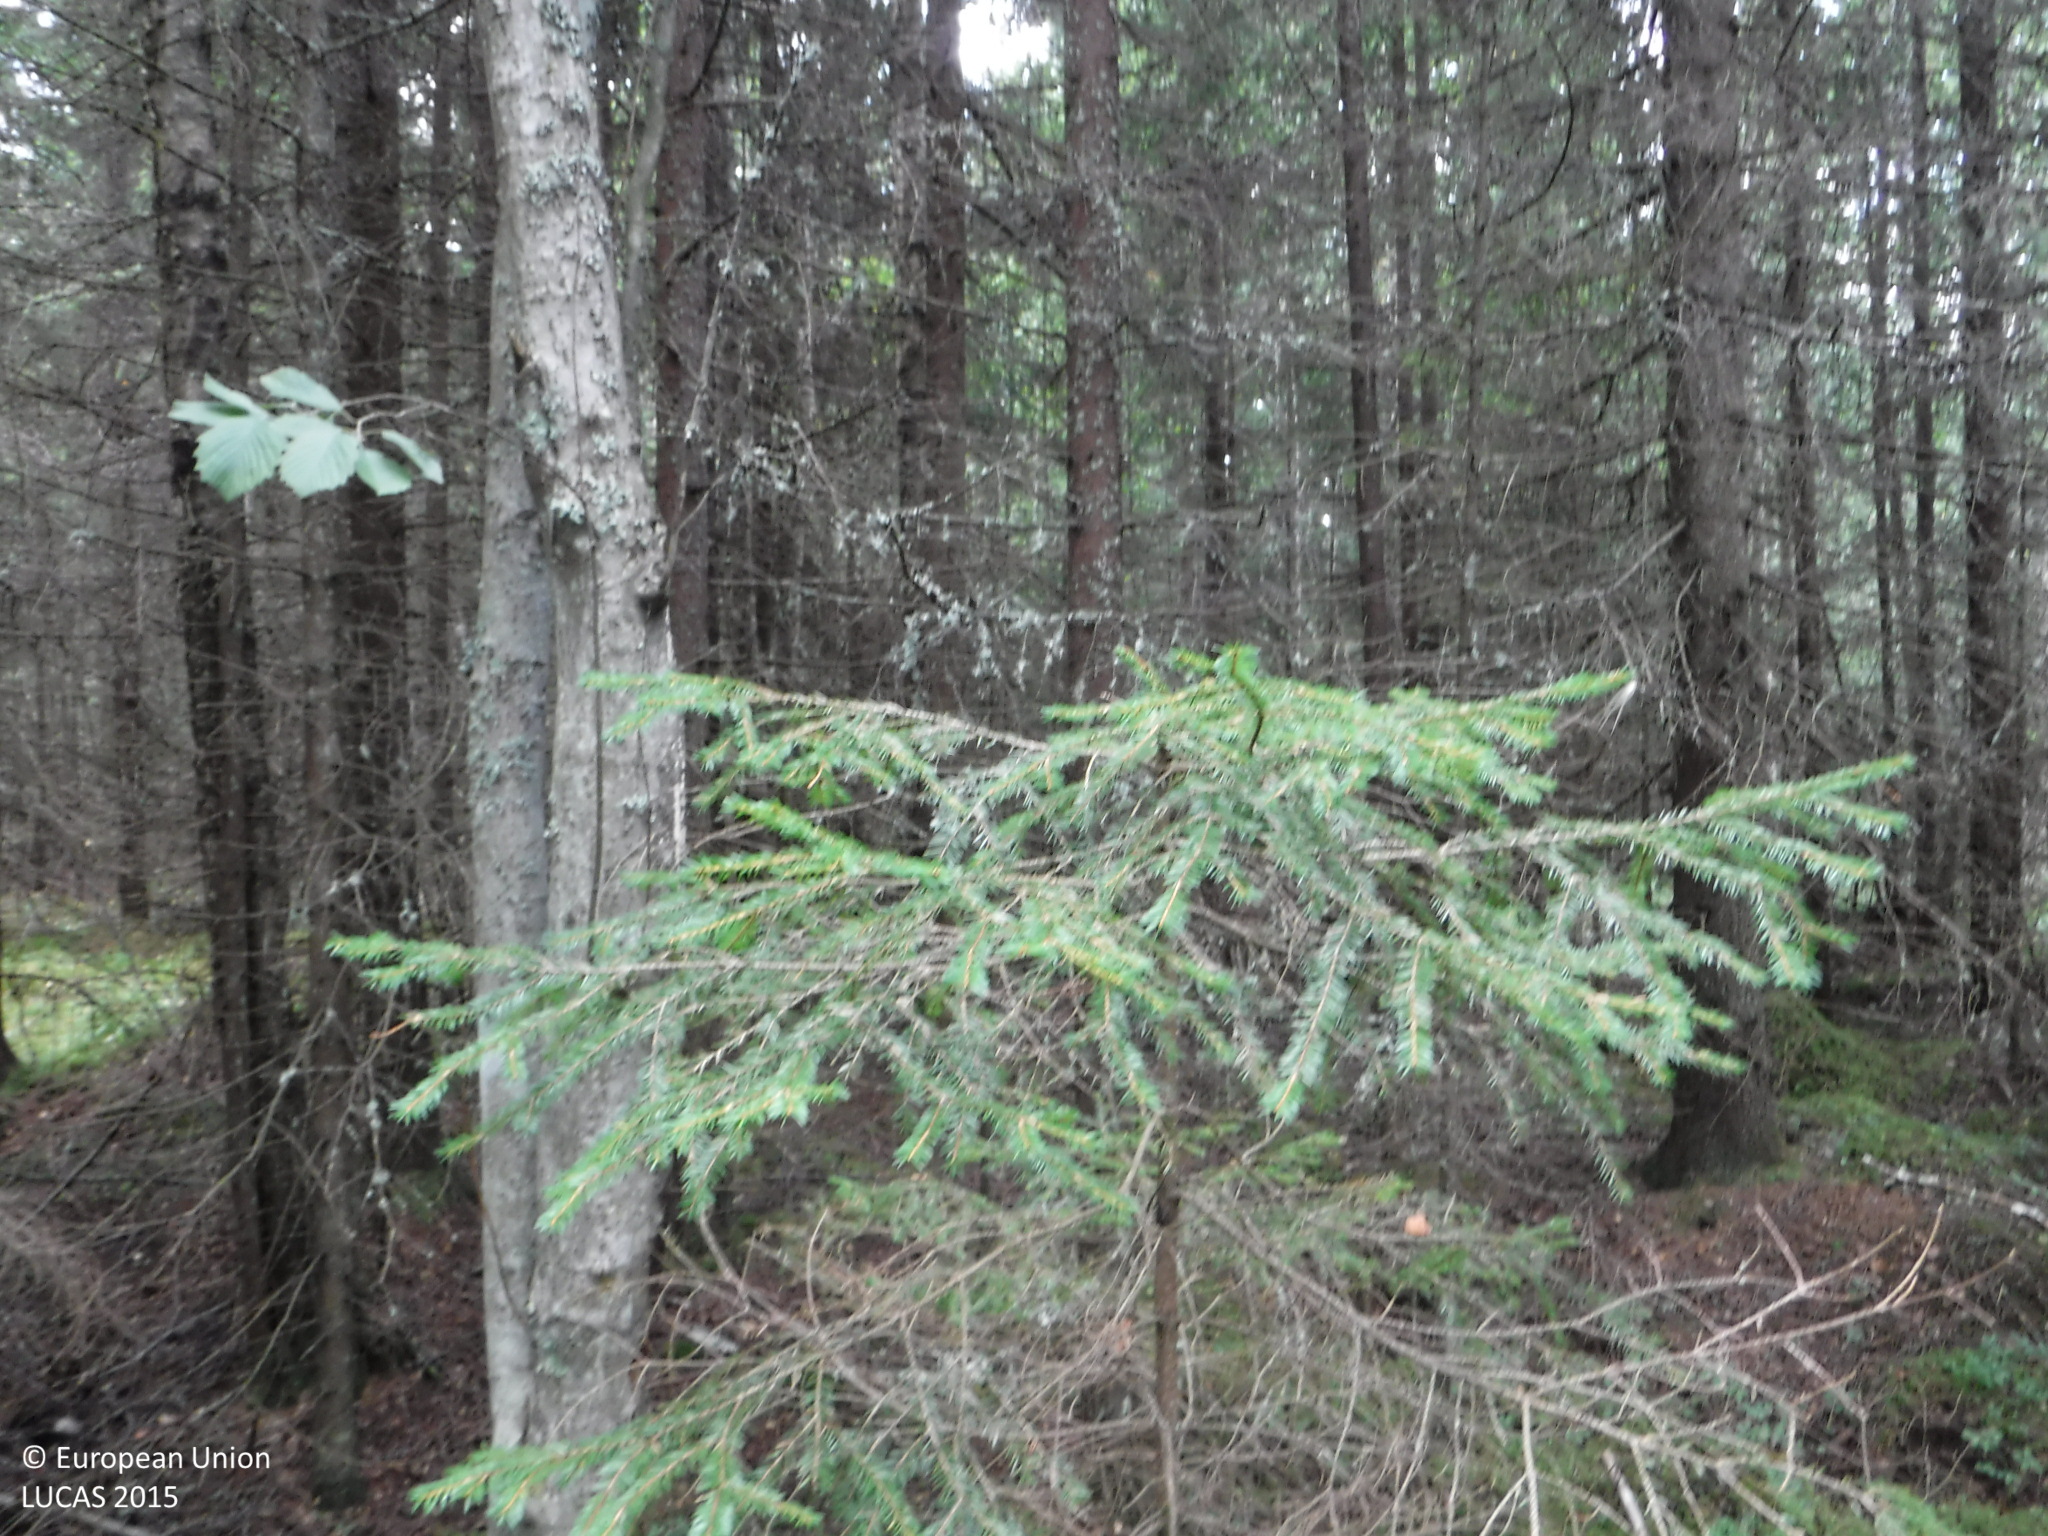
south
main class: Woodland
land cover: Spruce dominated mixed woodland
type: boreal forest
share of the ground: 50 - 75 %
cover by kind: coniferous forest trees 30 %, shrubs 25 %, broadleaved forest trees 20 %, lichens and mosses 20 %, herbaceous plants 5 %
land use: Forestry
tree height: > 5 m
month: August
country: FI
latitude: 61.2831
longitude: 21.8662
